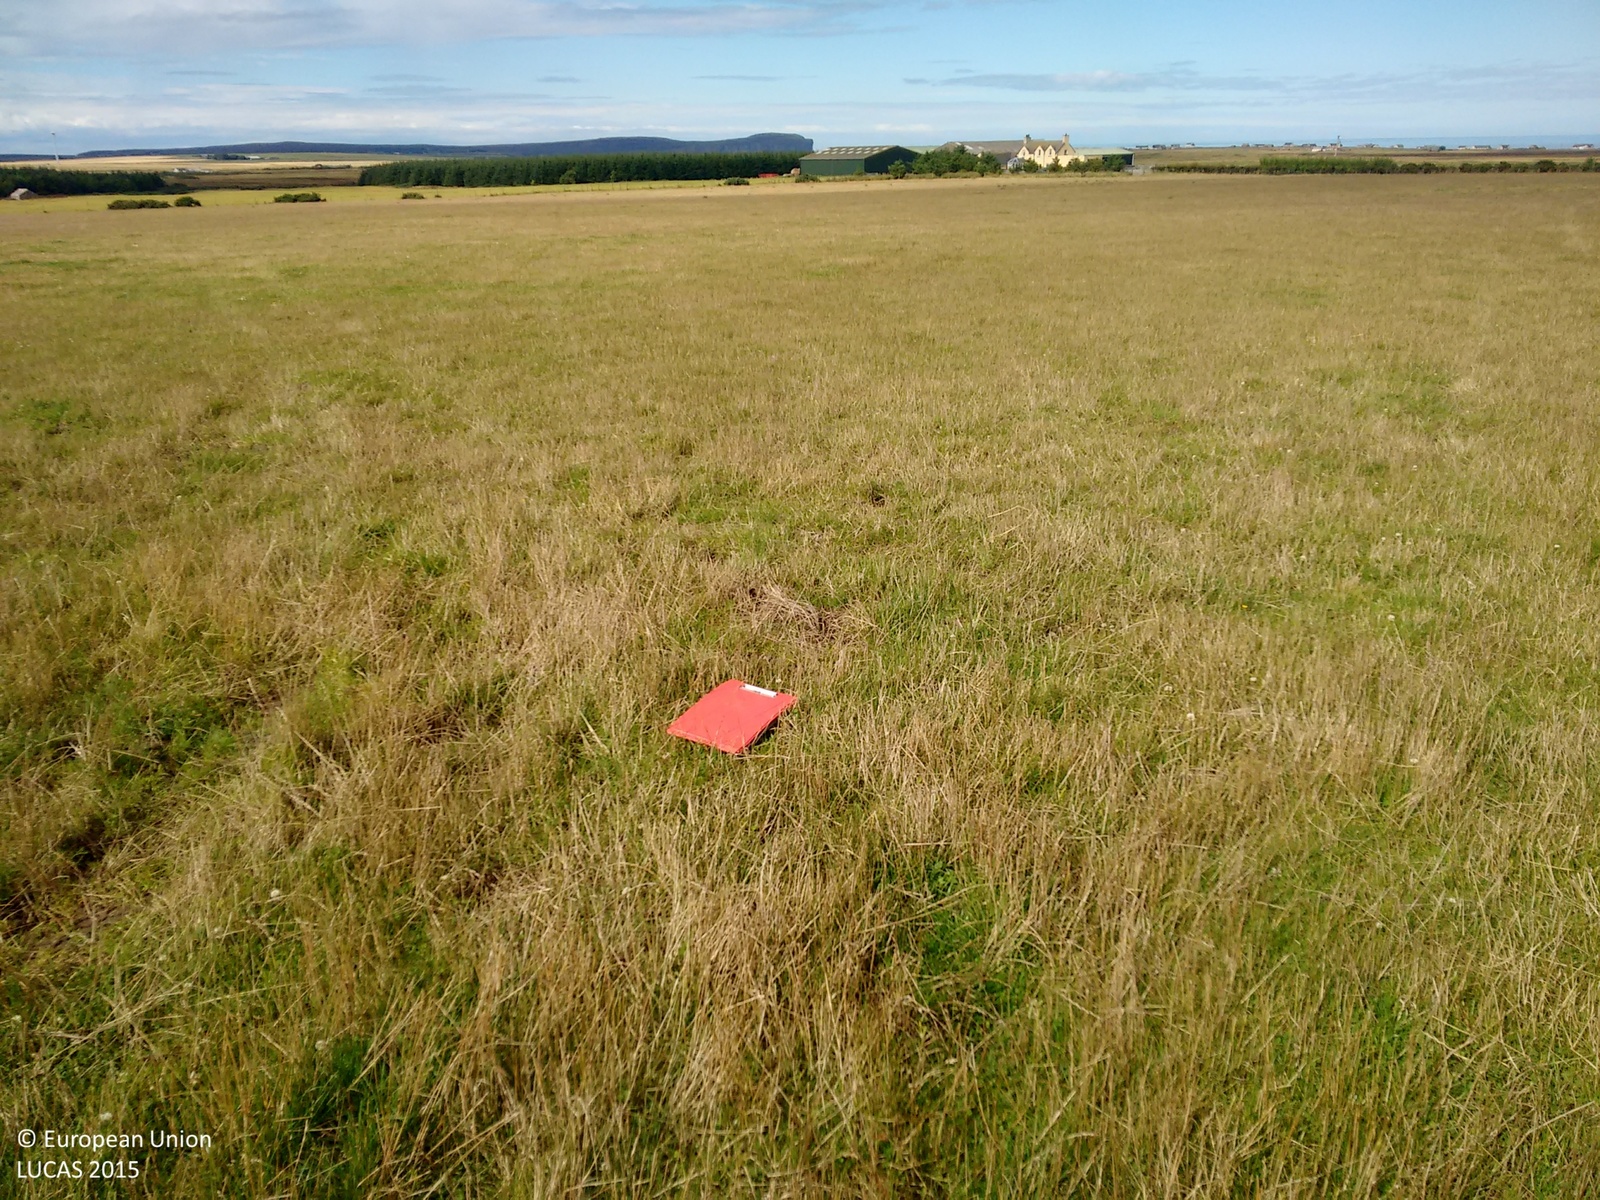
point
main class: Grassland
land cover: Grassland without tree/shrub cover
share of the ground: > 75 %
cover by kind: herbaceous plants 100 %
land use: Agriculture (excluding fallow land and kitchen gardens)
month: August
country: GB
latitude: 58.6388
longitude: -3.2378
